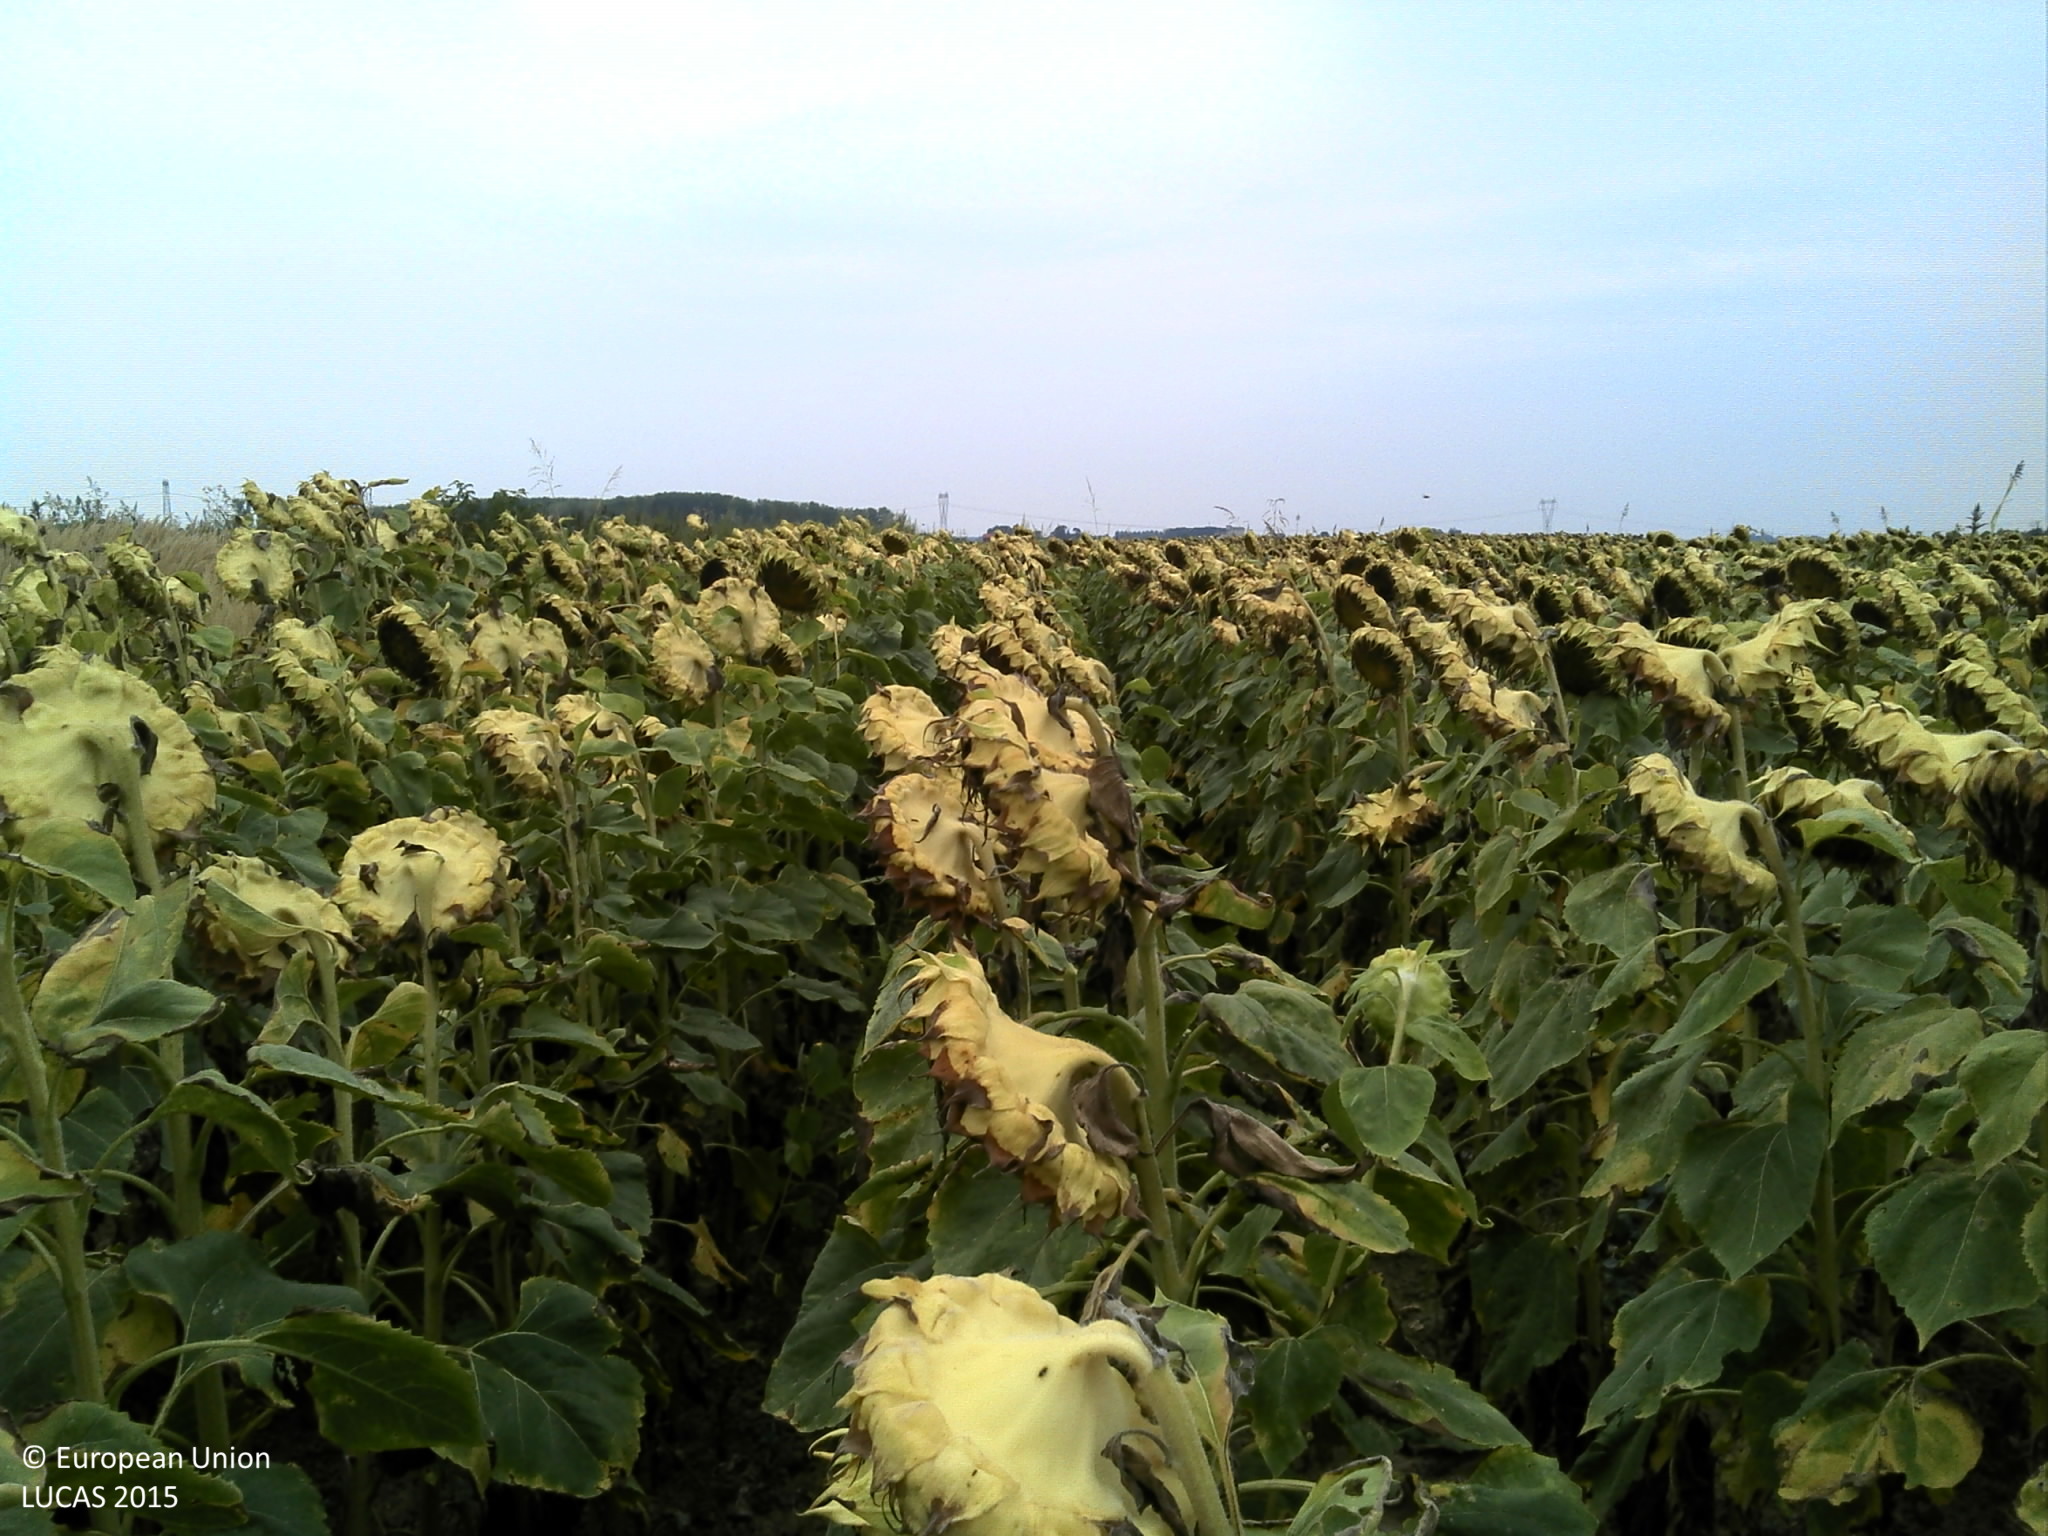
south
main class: Cropland
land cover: Sunflower
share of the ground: > 75 %
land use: Agriculture (excluding fallow land and kitchen gardens)
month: August
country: HR
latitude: 45.4681
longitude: 18.5119
